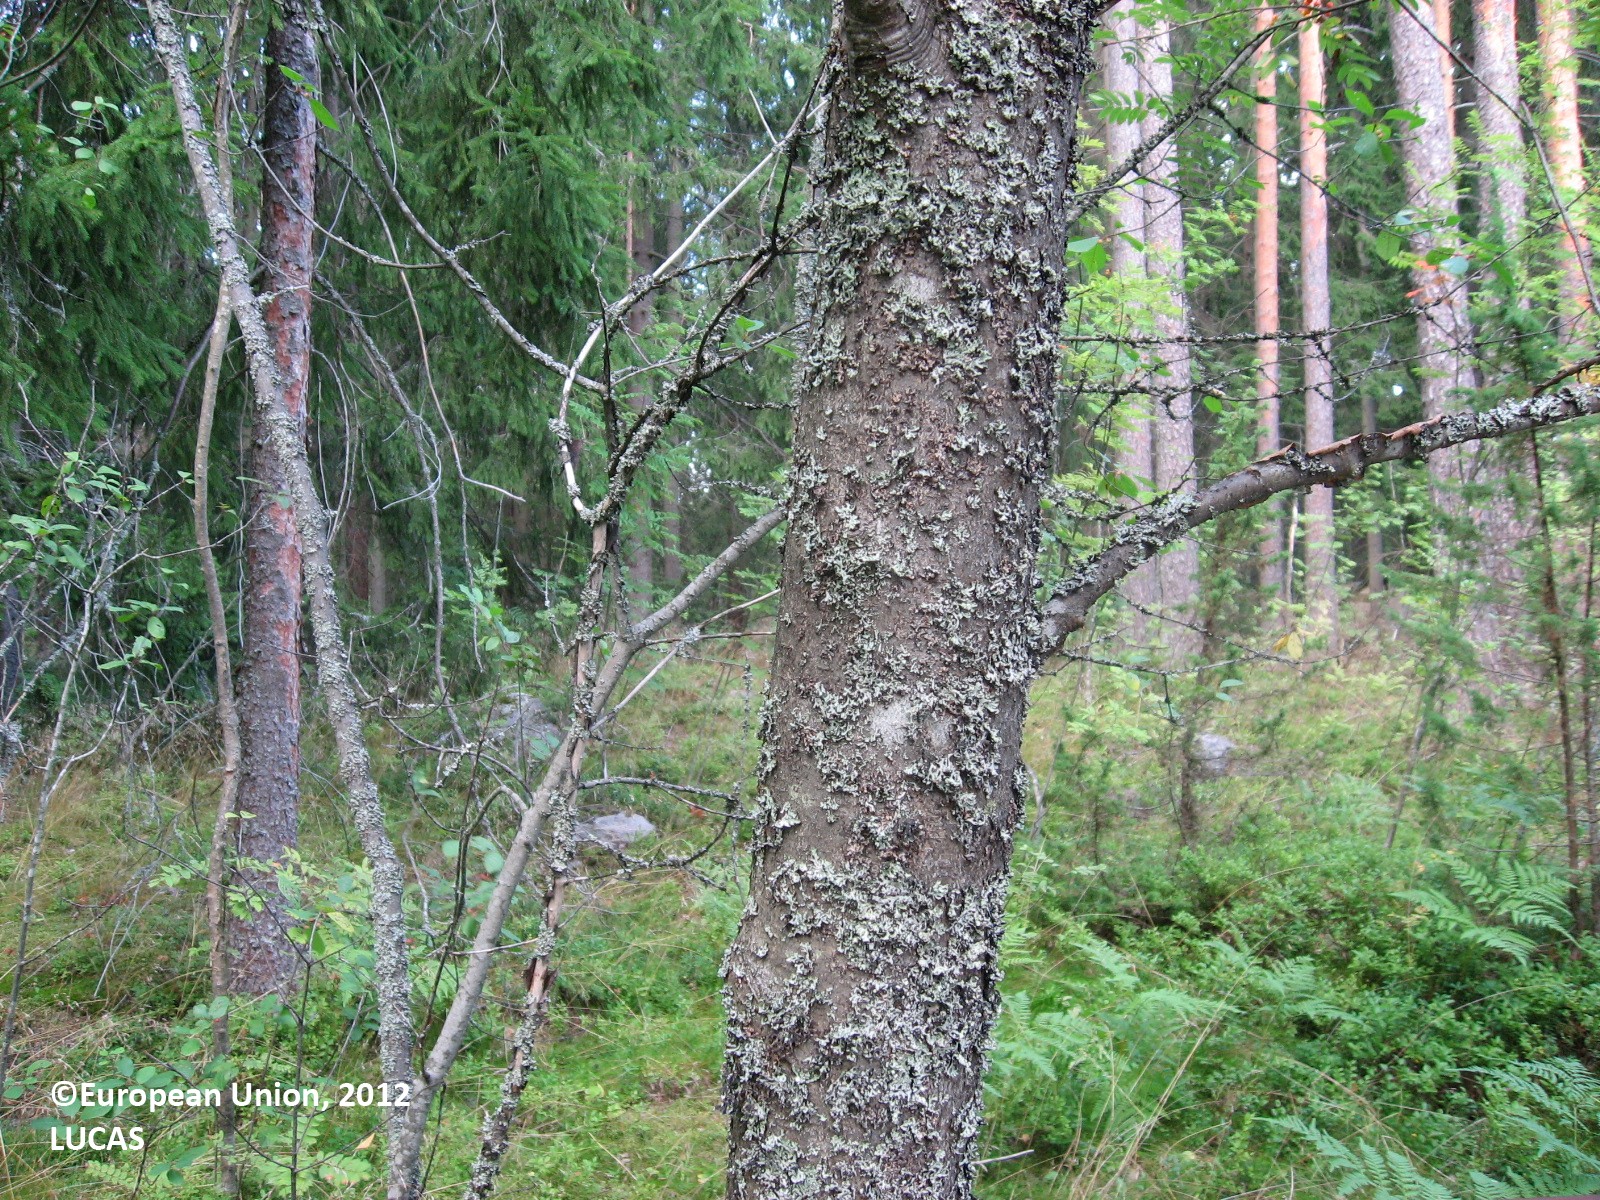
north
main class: Woodland
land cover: Spruce dominated mixed woodland
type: boreal forest
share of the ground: 50 - 75 %
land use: Forestry
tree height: > 5 m
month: August
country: FI
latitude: 60.5959
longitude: 25.4095
